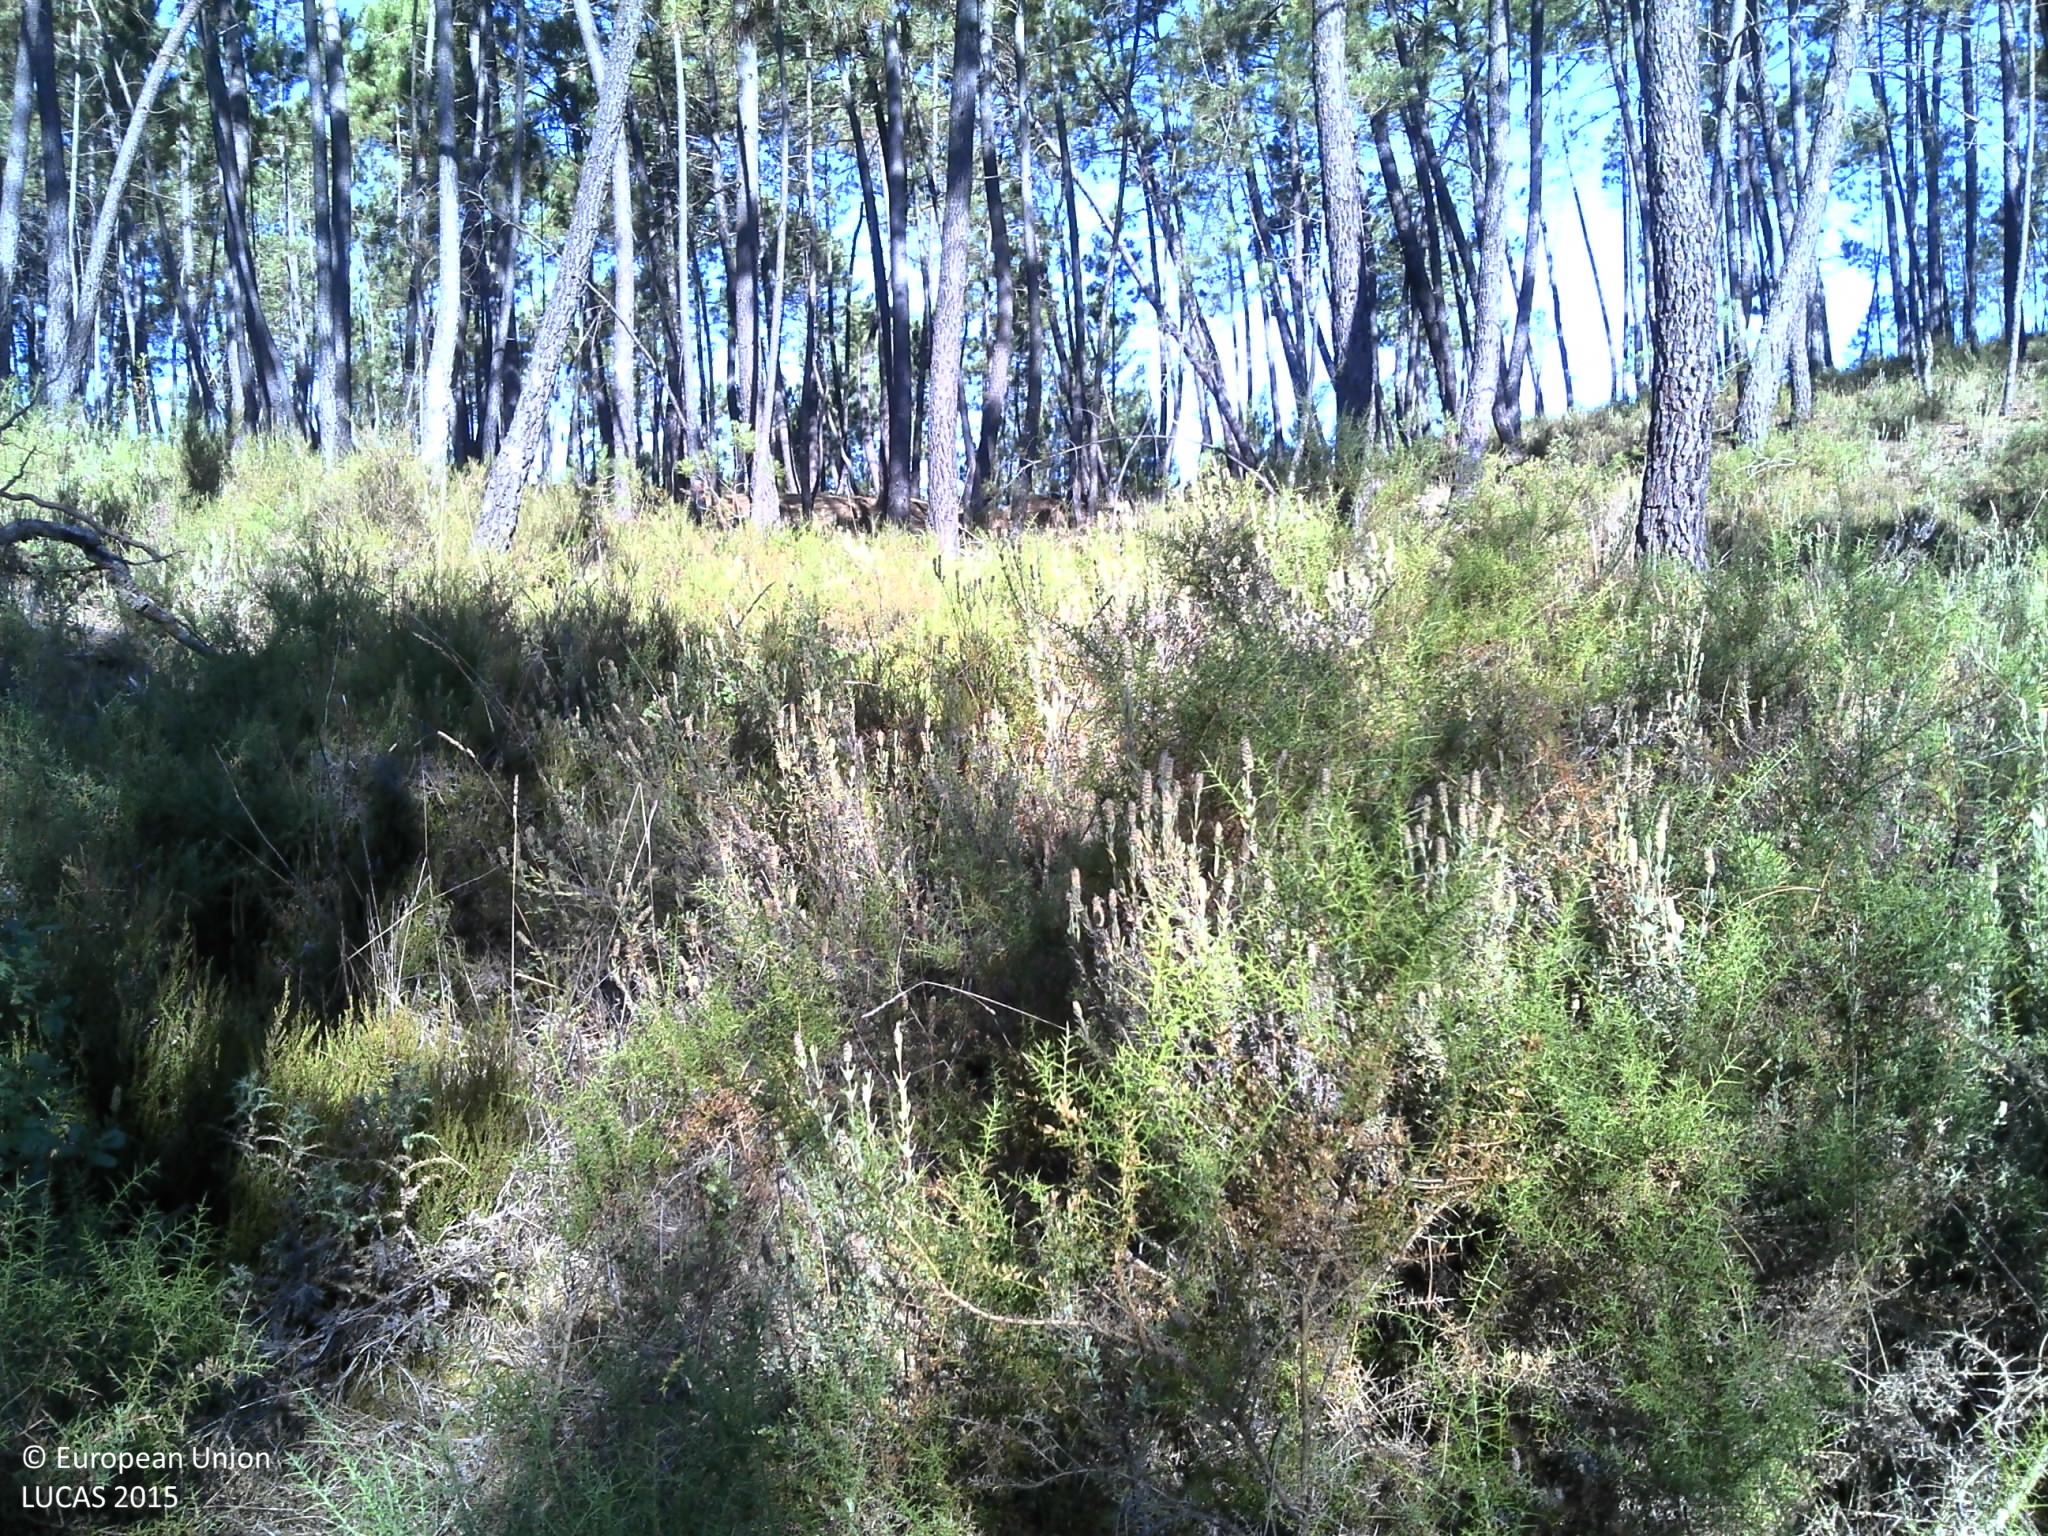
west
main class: Woodland
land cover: Pine dominated coniferous woodland
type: coniferous forest of the mediterranean region
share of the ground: 25 - 50 %
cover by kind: shrubs 75 %, coniferous forest trees 25 %
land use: Forestry
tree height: > 5 m
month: July
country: PT
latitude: 39.7646
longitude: -8.1259
